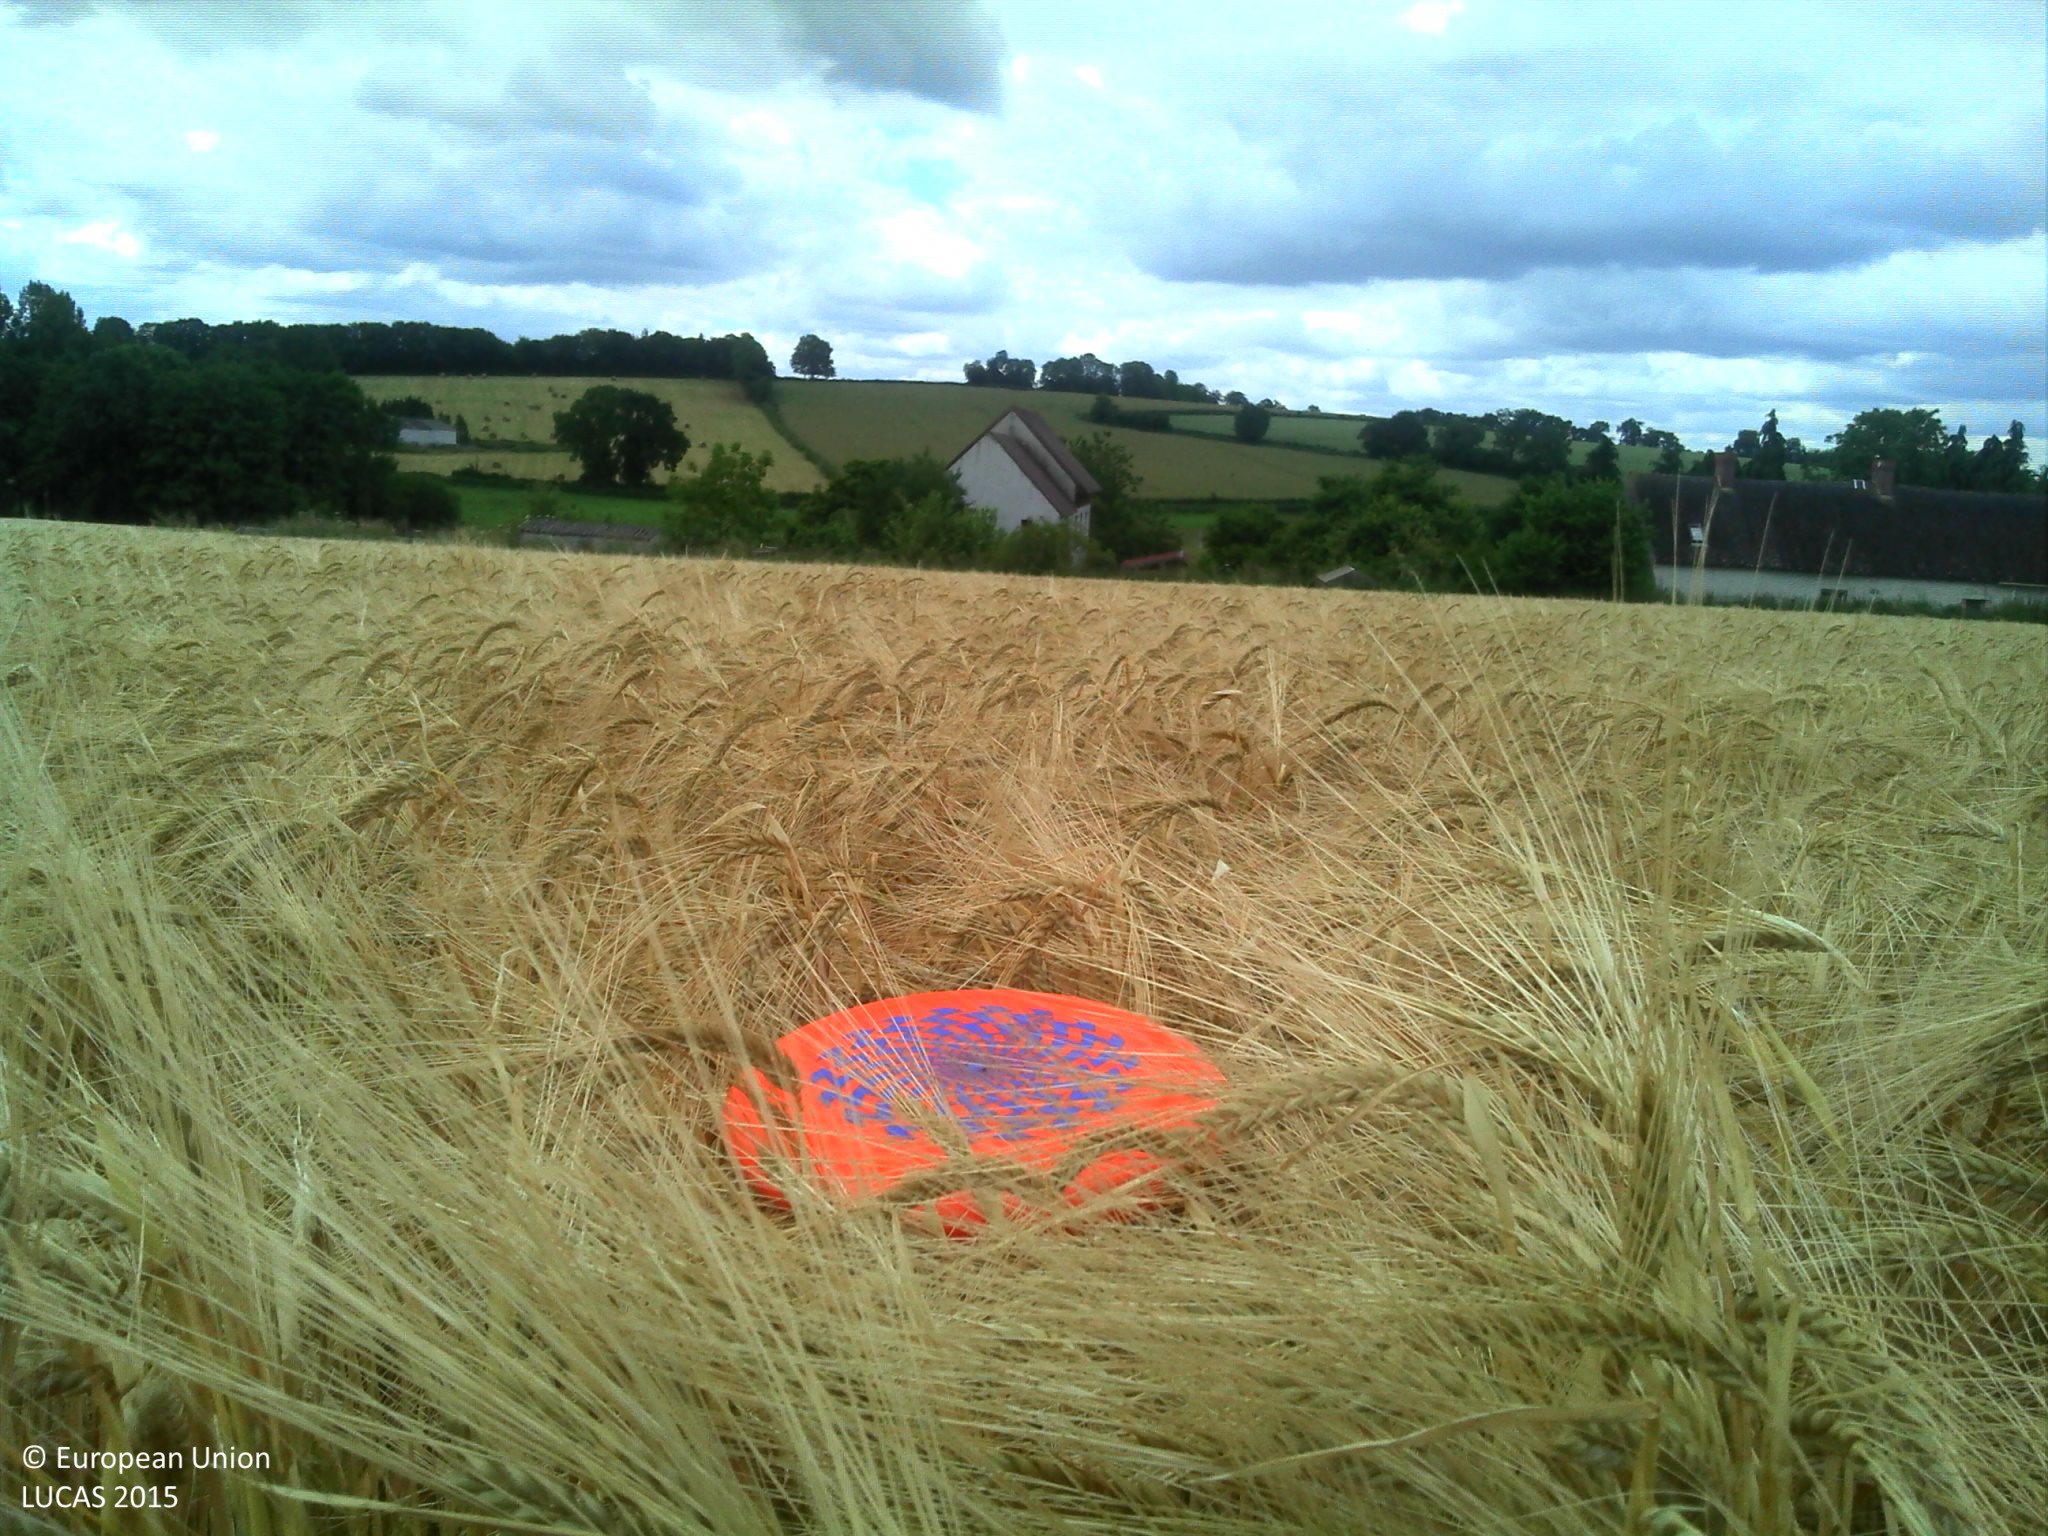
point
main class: Cropland
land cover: Barley
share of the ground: > 75 %
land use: Agriculture (excluding fallow land and kitchen gardens)
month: June
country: FR
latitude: 48.7068
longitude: -0.2380
